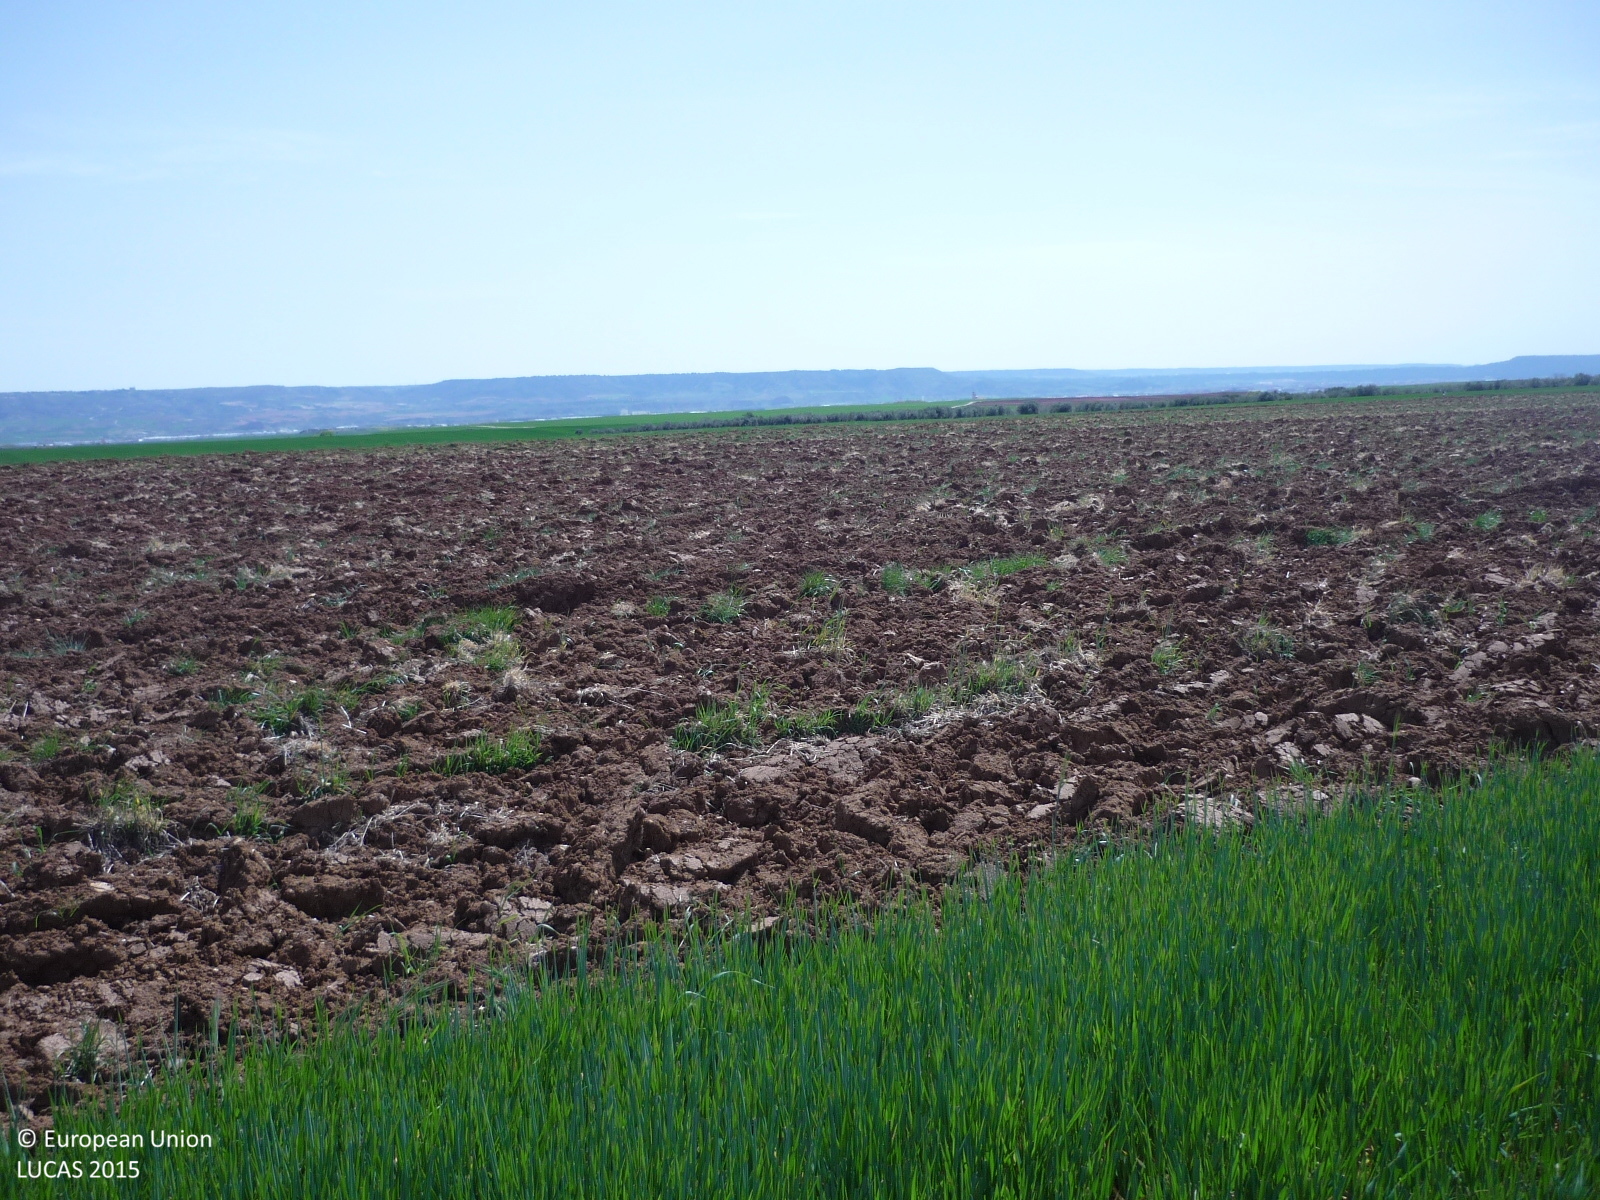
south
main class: Cropland
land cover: Common wheat
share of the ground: > 75 %
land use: Agriculture (excluding fallow land and kitchen gardens)
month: April
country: ES
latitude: 40.5982
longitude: -3.3291
